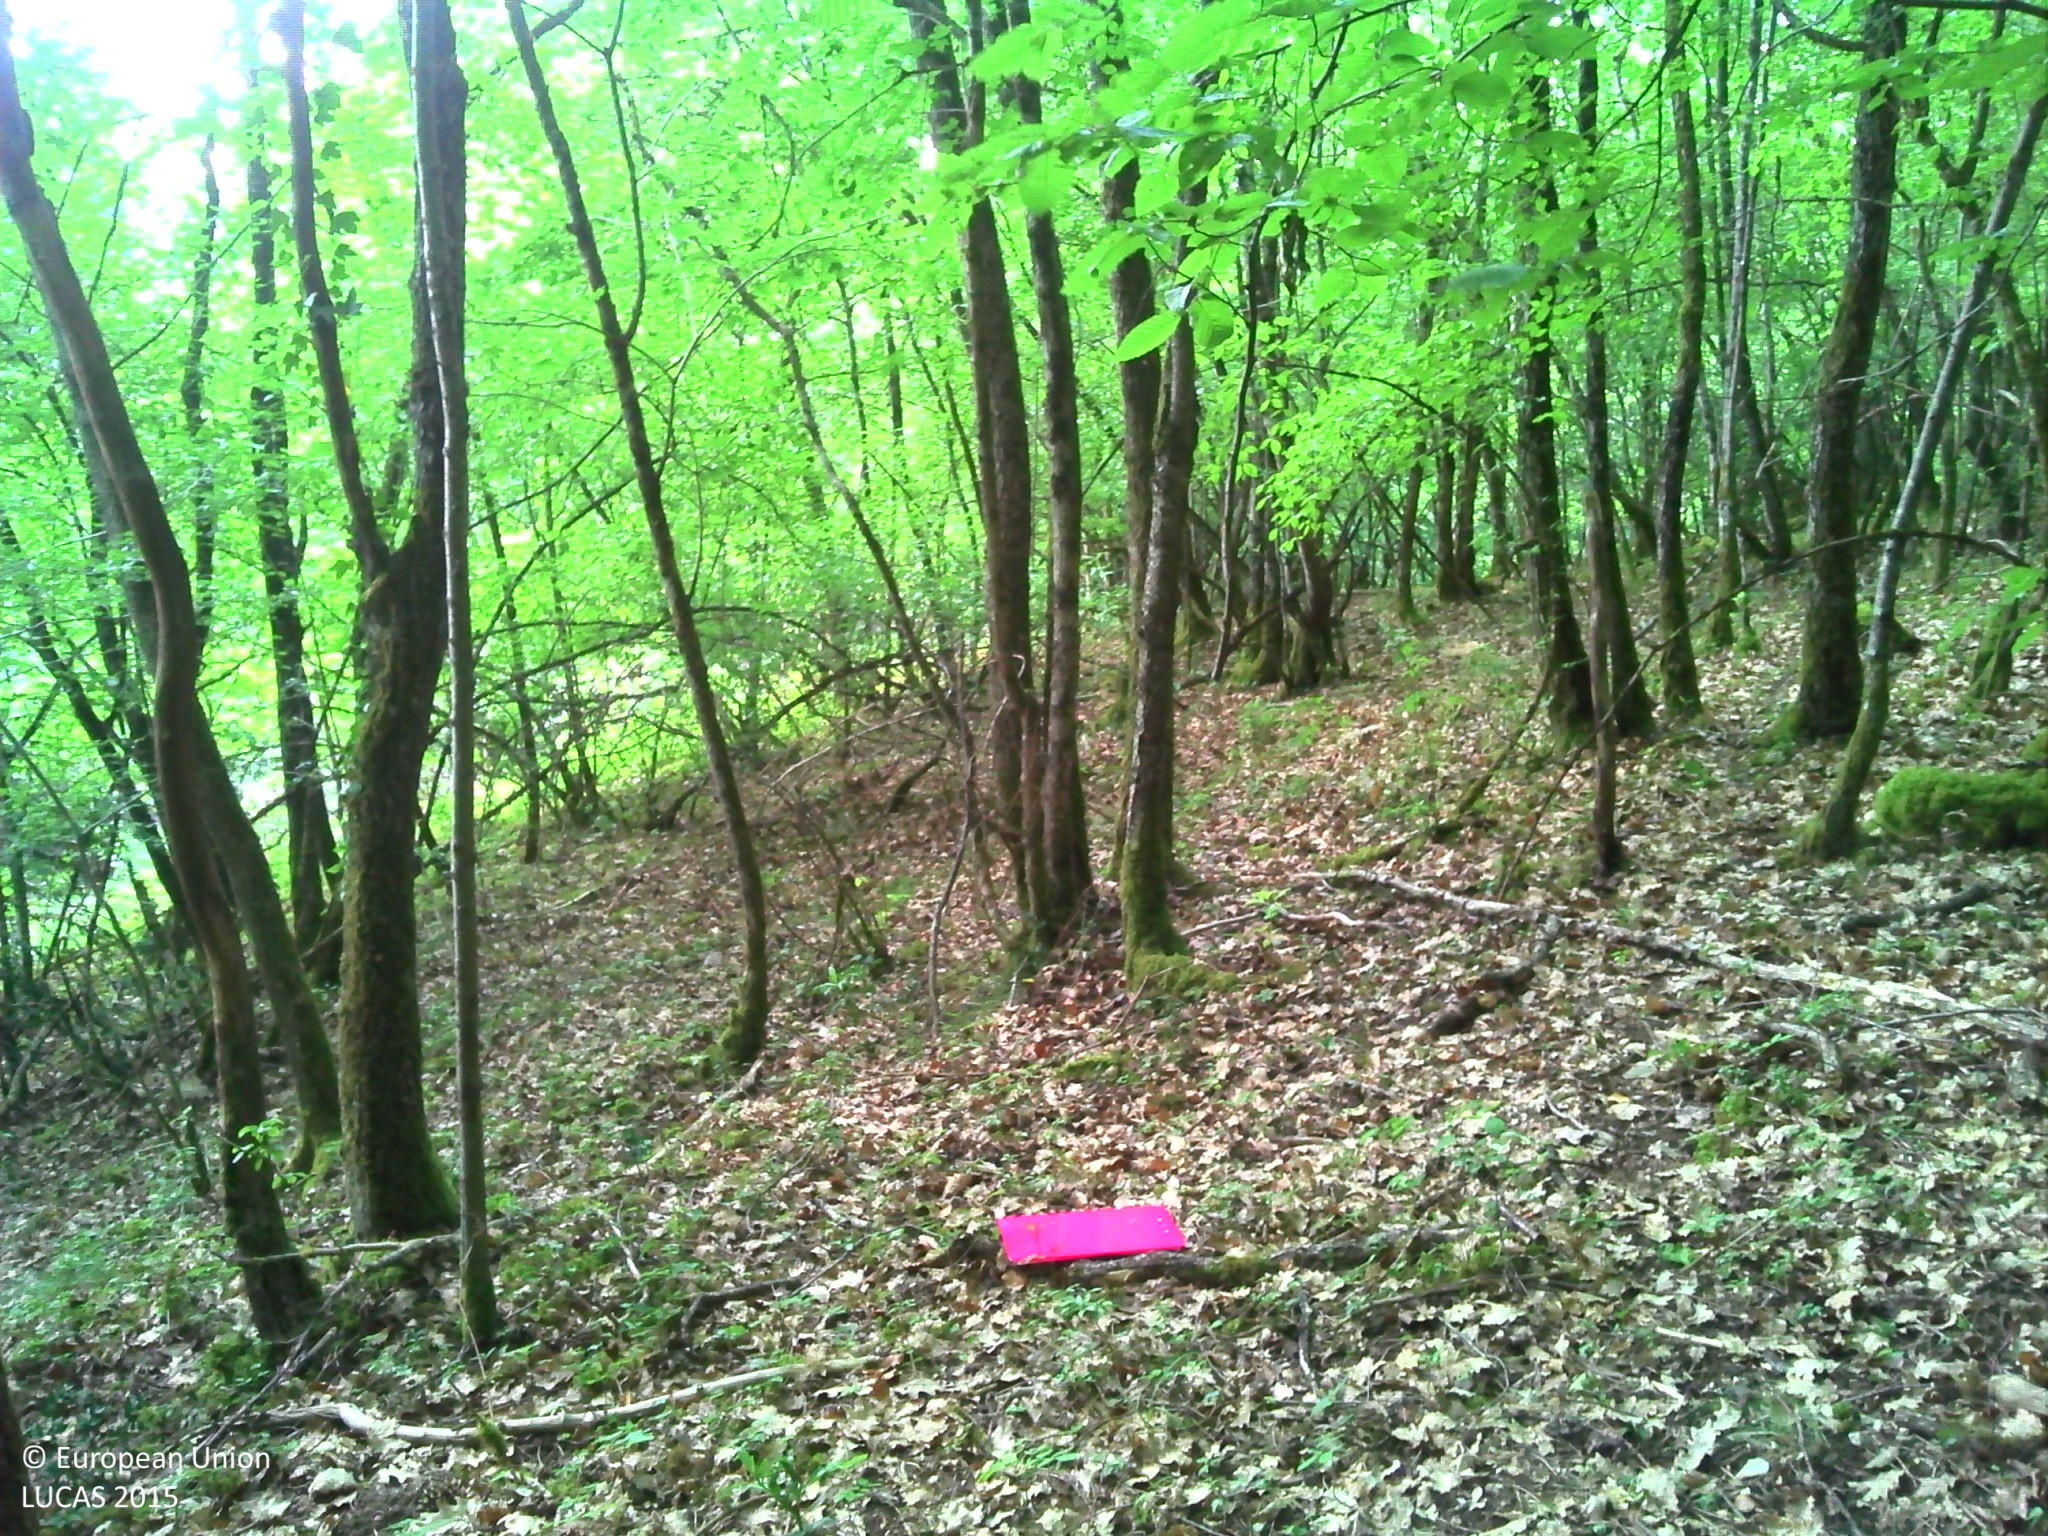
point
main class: Woodland
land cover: Pine dominated mixed woodland
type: mesophytic deciduous forest
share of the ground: > 75 %
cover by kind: broadleaved forest trees 55 %, coniferous forest trees 25 %, herbaceous plants 15 %, lichens and mosses 5 %
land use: Forestry
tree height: > 5 m
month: May
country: FR
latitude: 47.3137
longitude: 4.9338
